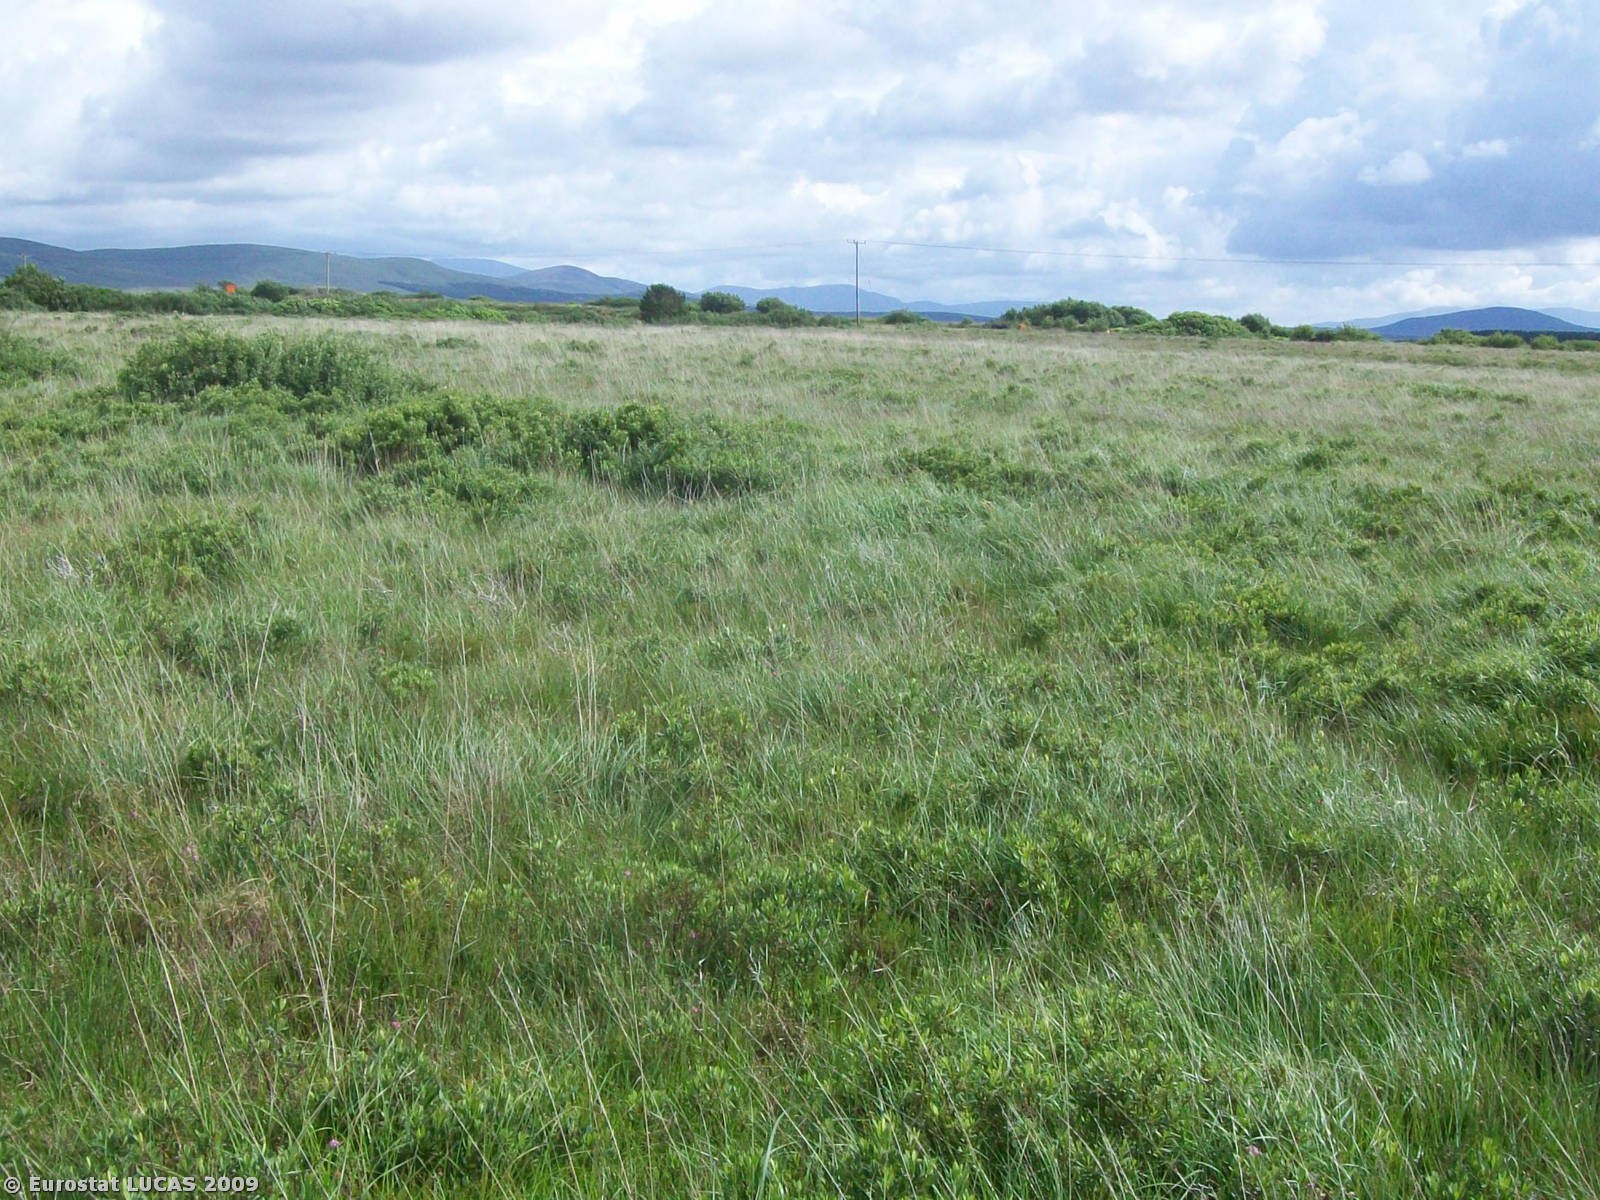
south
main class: Wetlands
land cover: Peatbogs
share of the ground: > 75 %
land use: Mining and quarrying
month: July
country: IE
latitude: 54.1600
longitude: -9.7687
